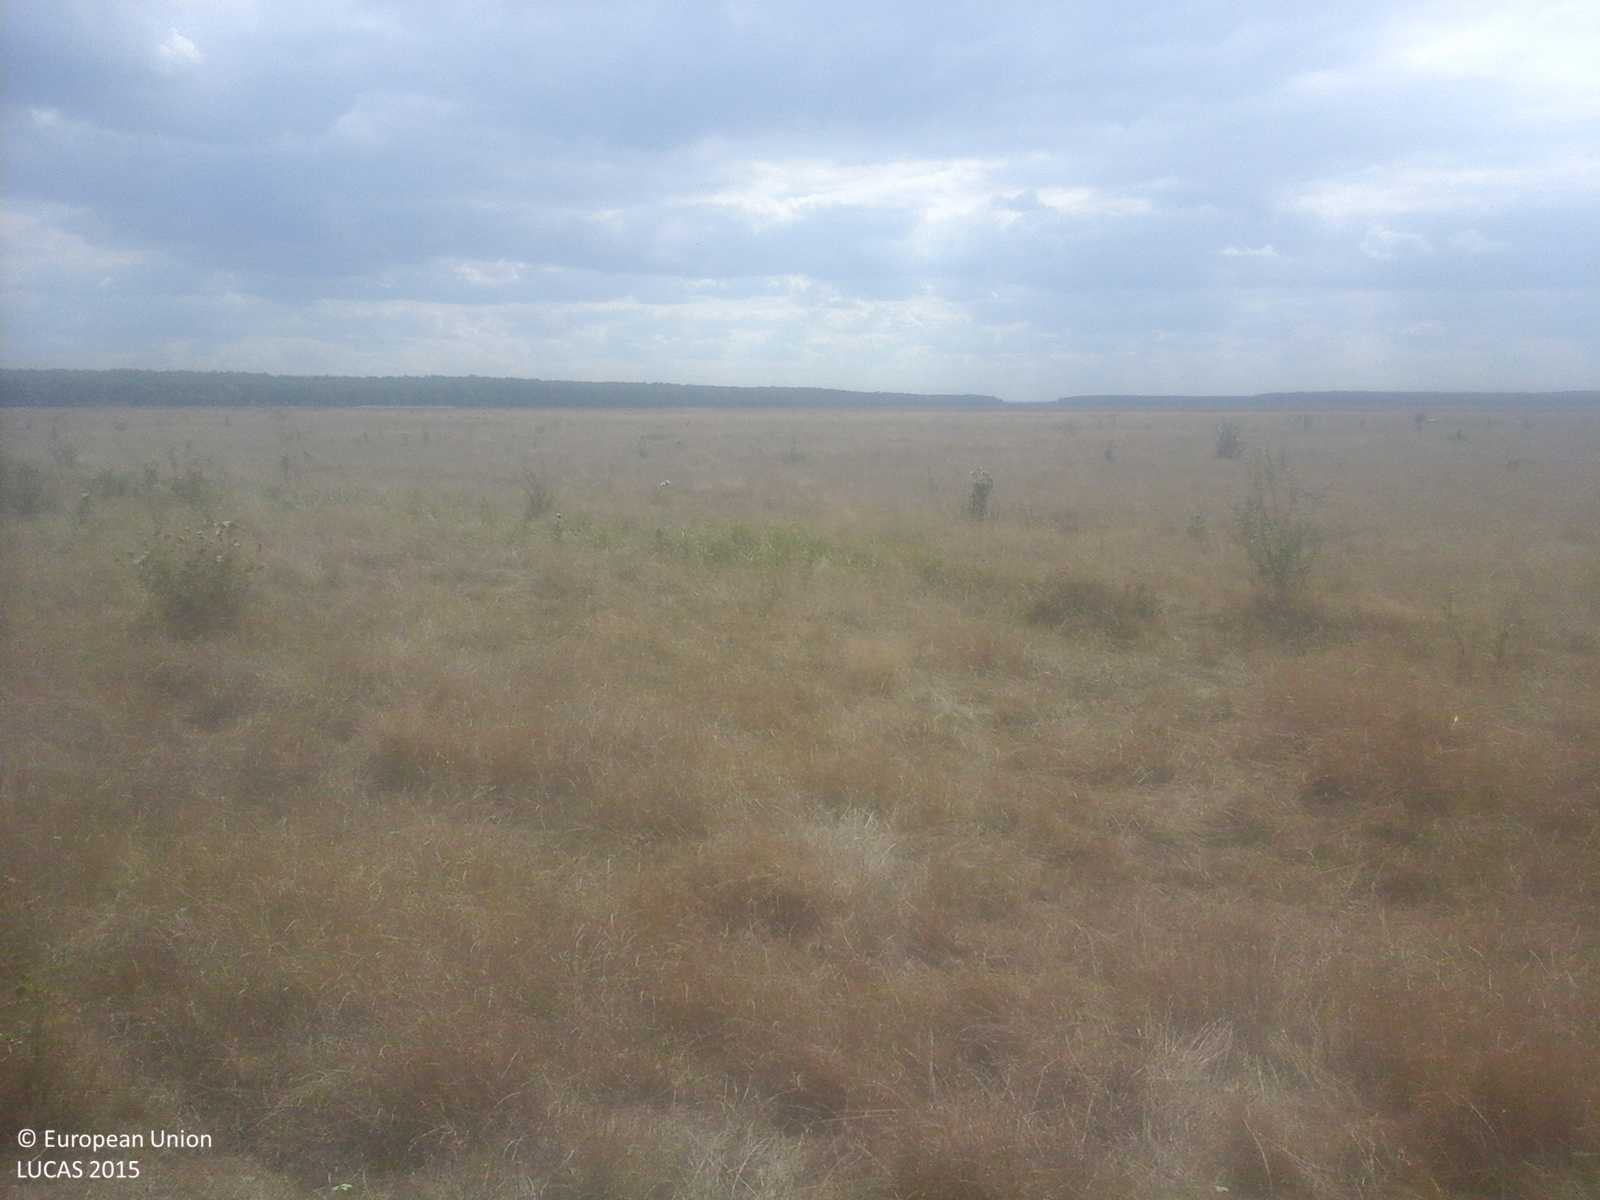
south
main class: Grassland
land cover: Spontaneously vegetated surfaces
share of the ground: > 75 %
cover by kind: herbaceous plants 100 %
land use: Fallow land
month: September
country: RO
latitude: 47.7261
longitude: 22.8224
